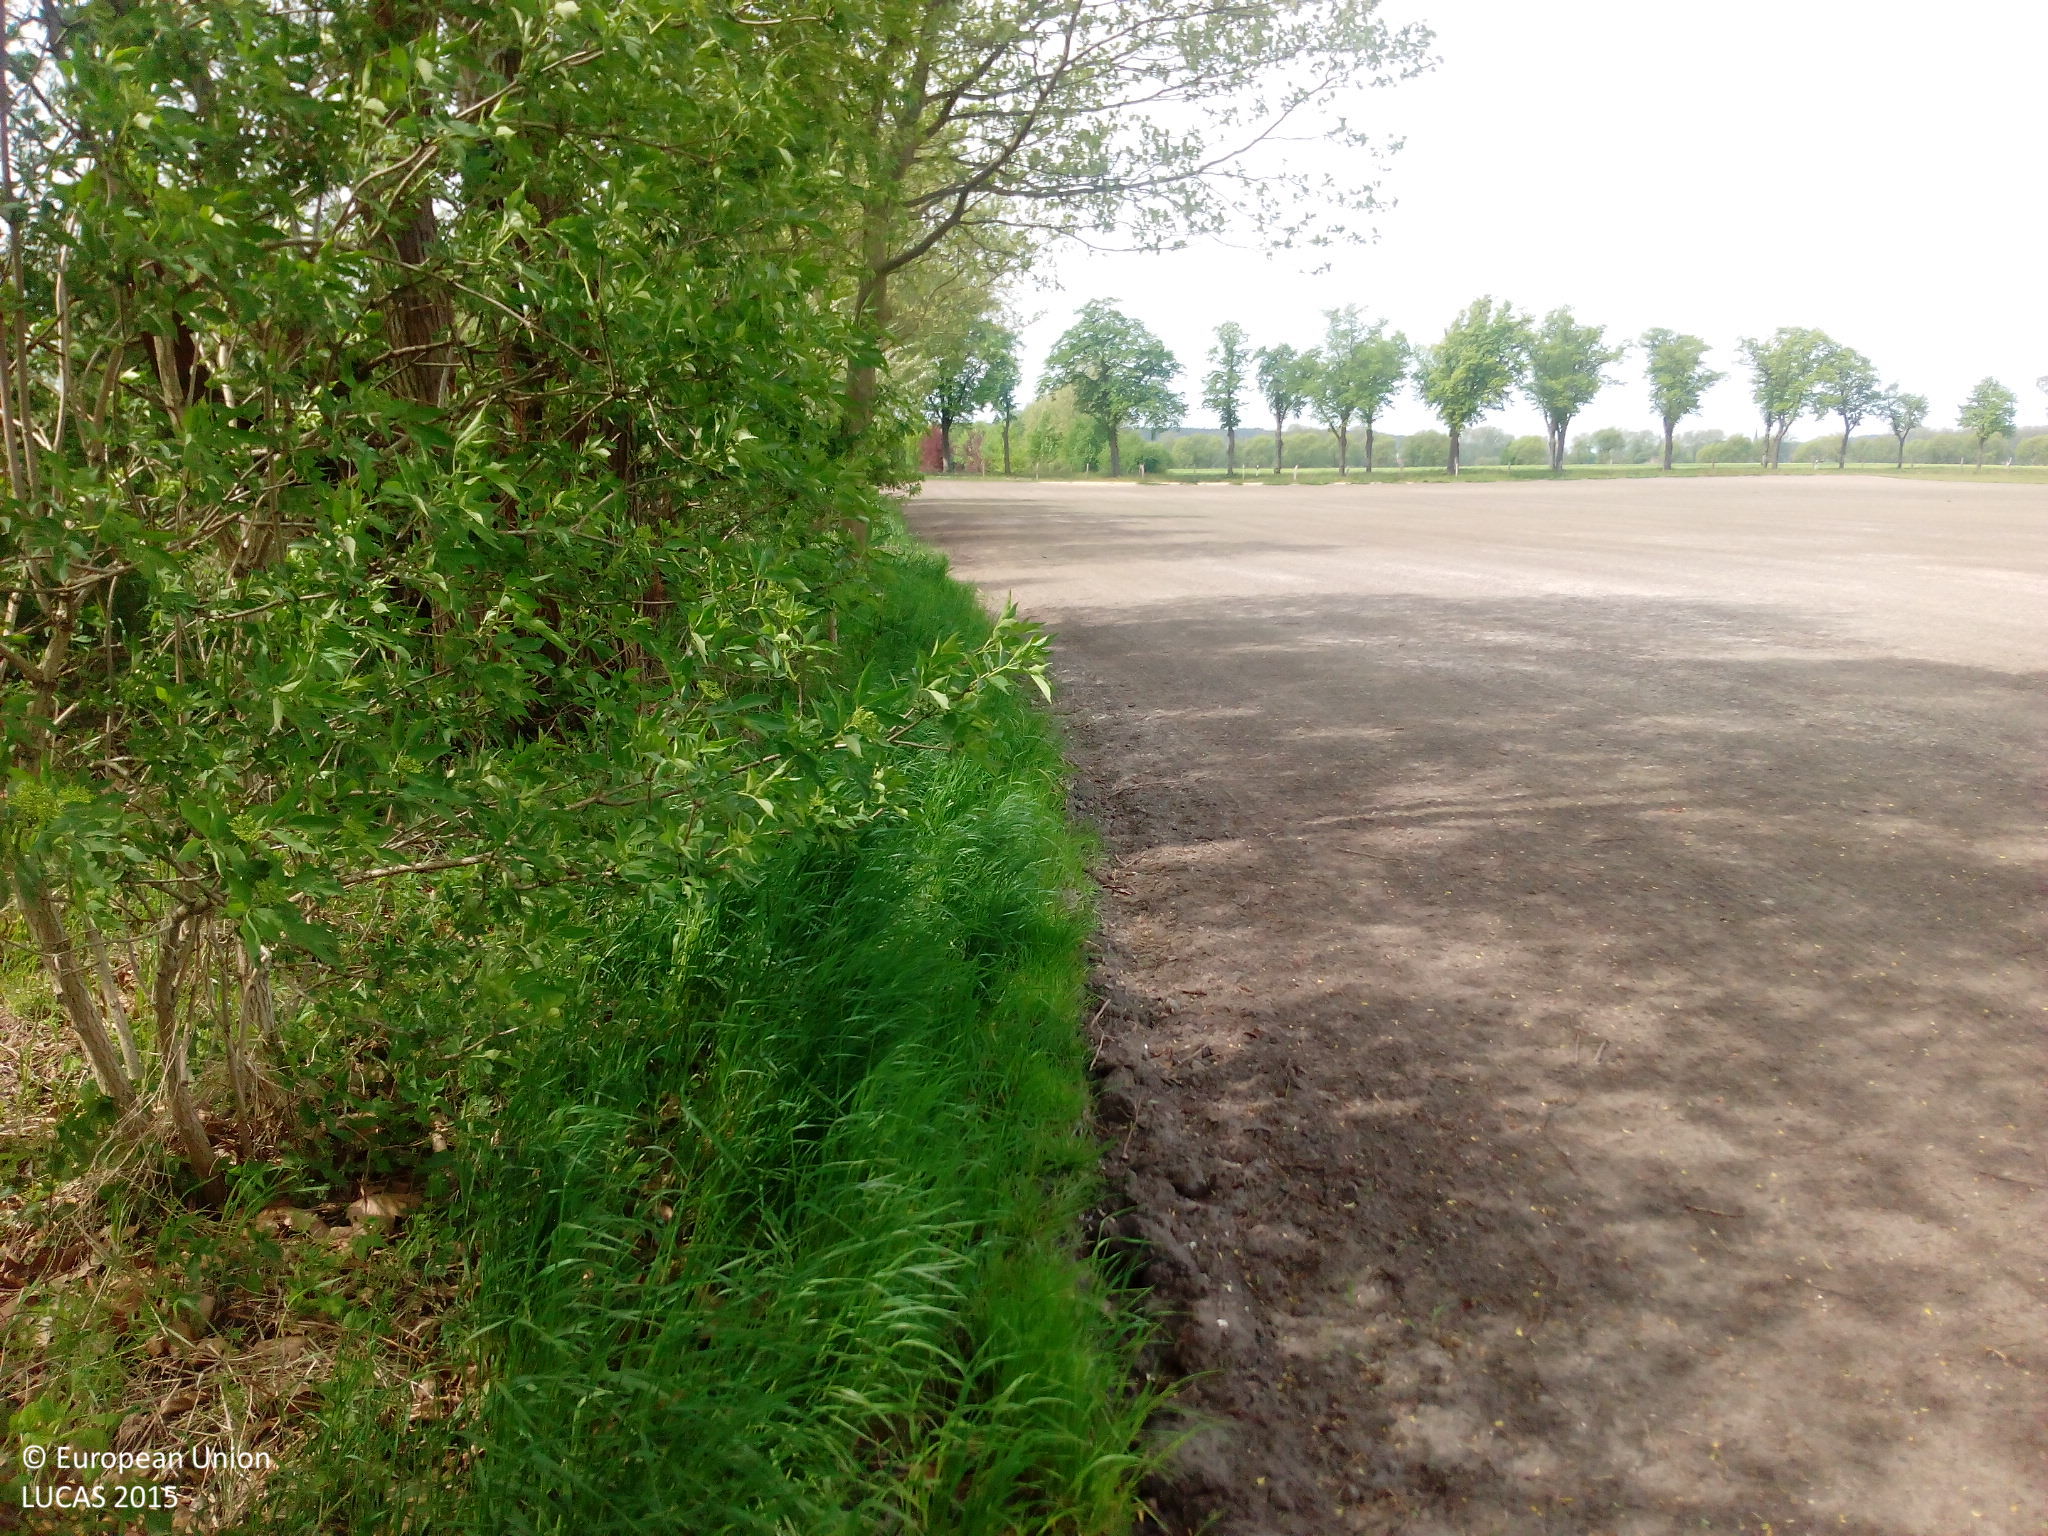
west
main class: Grassland
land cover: Grassland without tree/shrub cover
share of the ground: > 75 %
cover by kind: unconsolidated bare surface 90 %, herbaceous plants 10 %
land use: Agriculture (excluding fallow land and kitchen gardens)
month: May
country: DE
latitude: 52.3176
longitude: 13.1540
